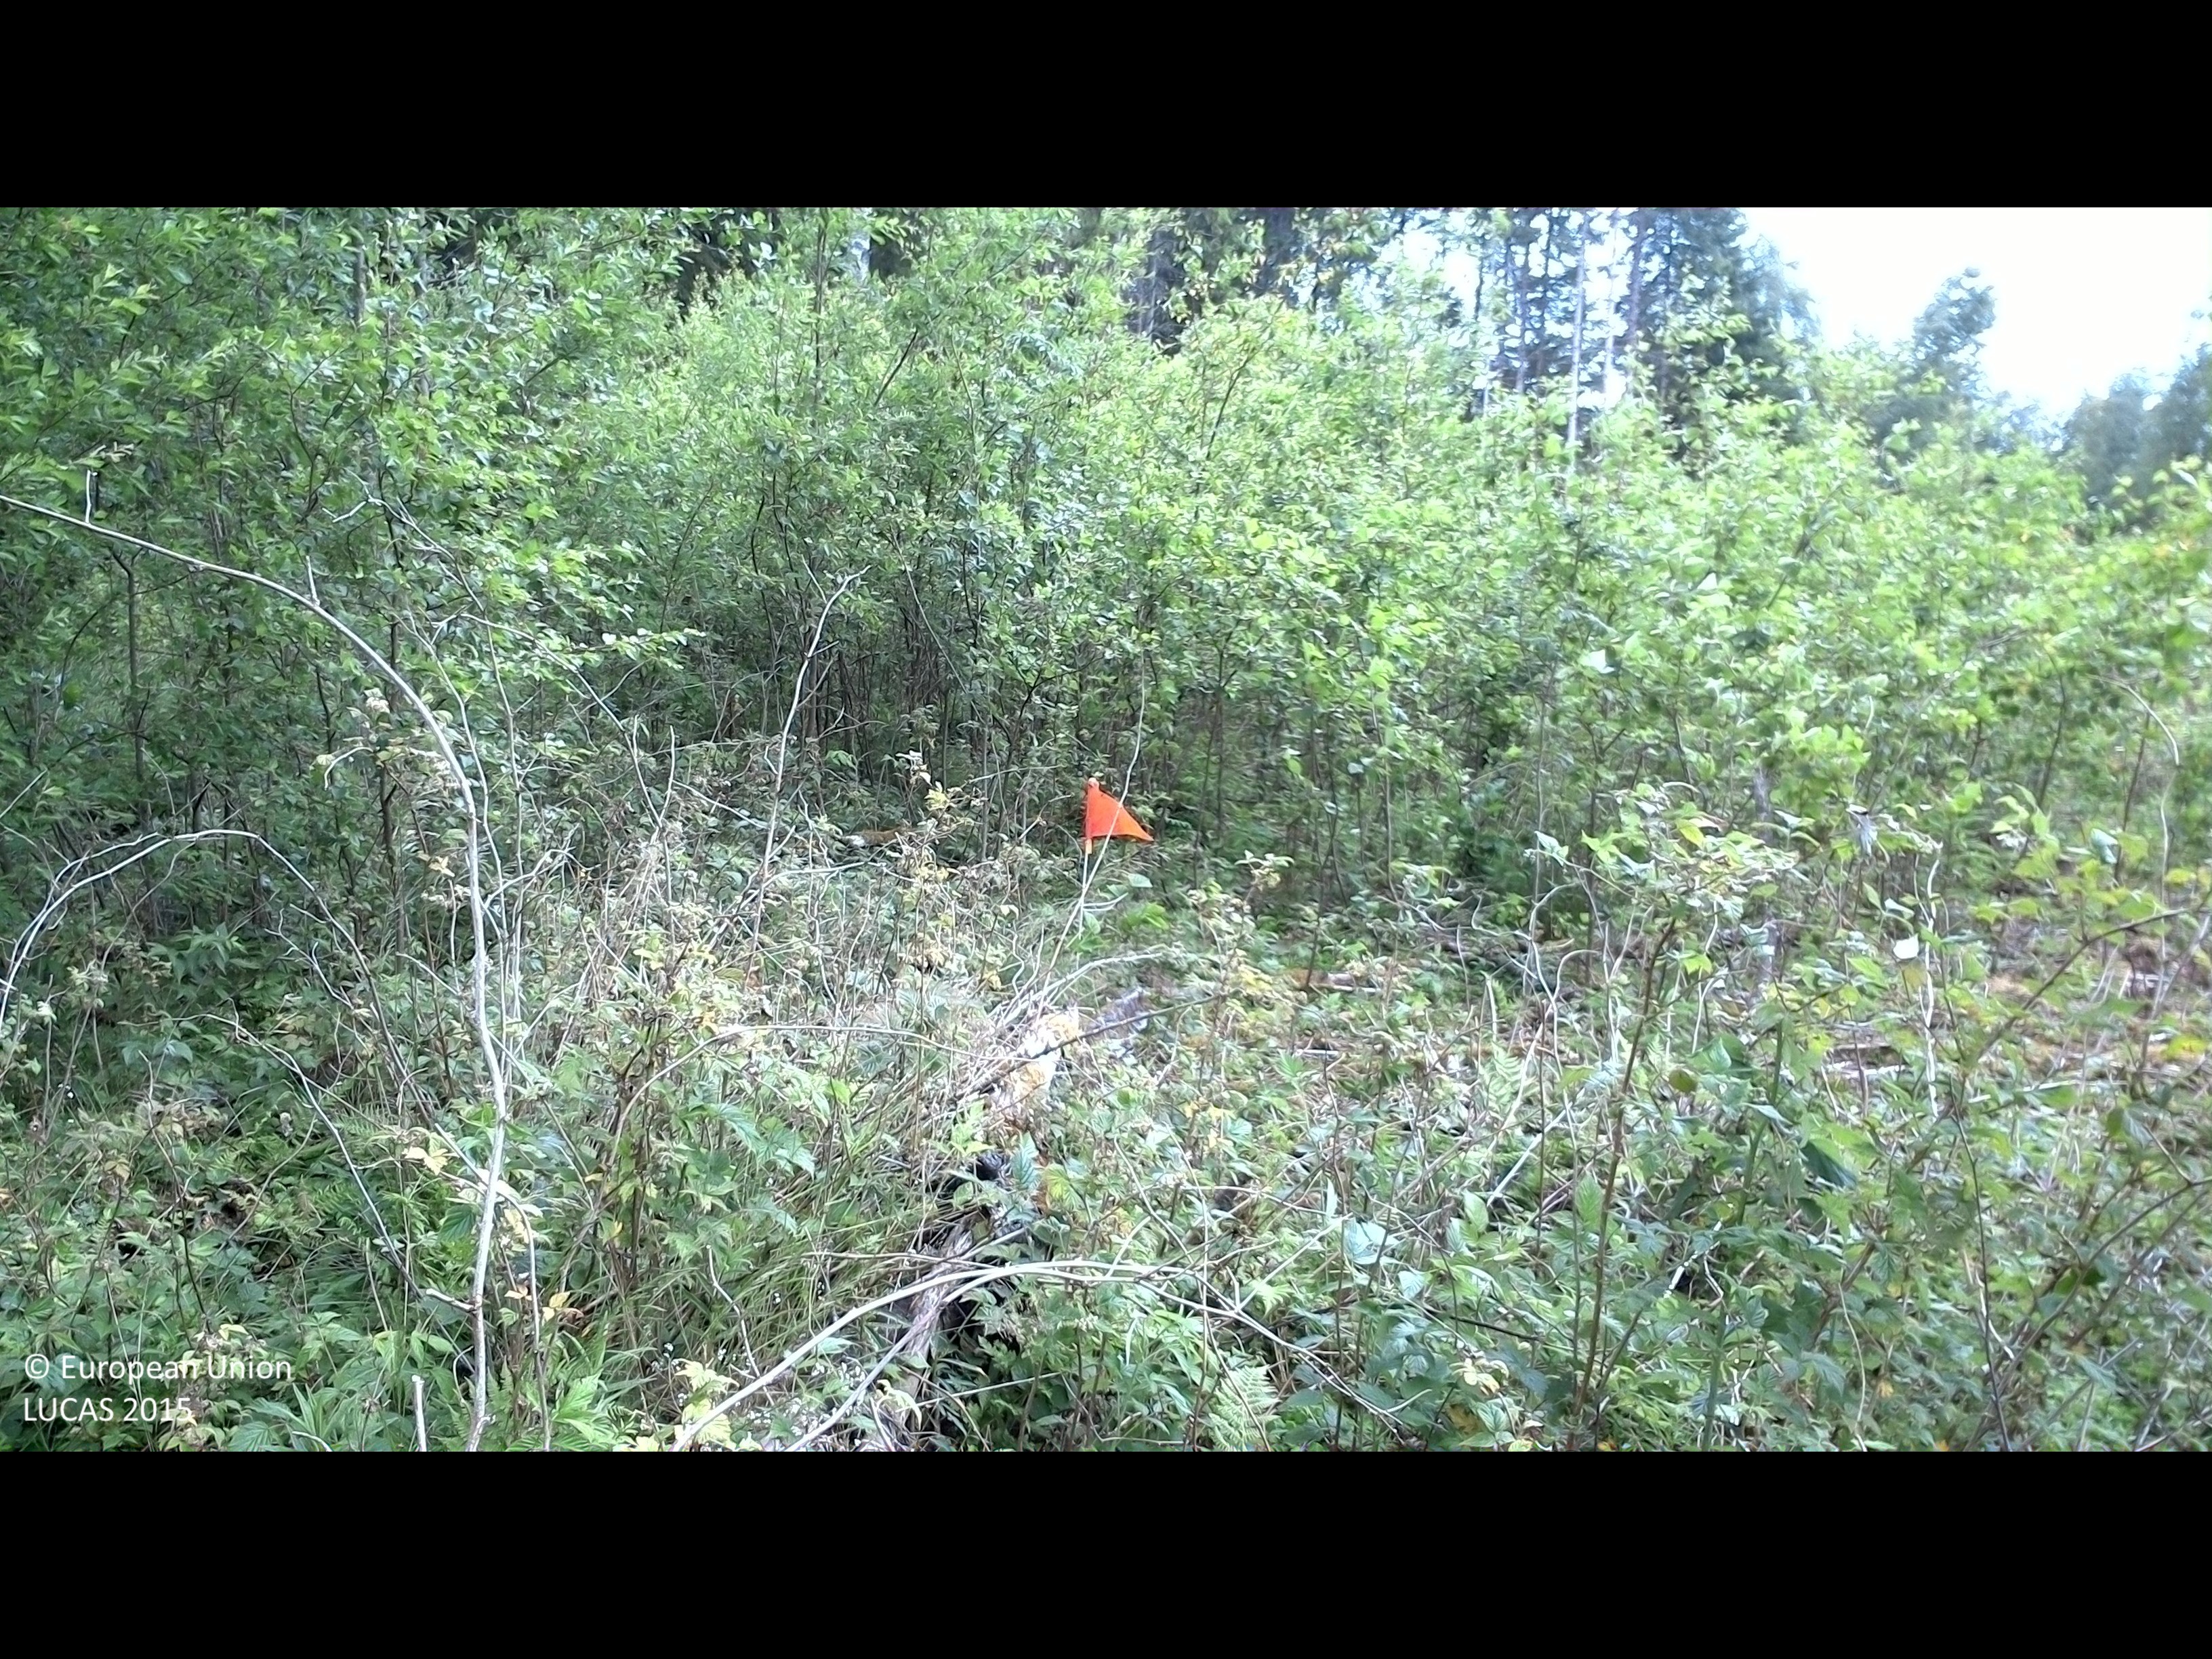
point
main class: Woodland
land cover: Broadleaved woodland
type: boreal forest
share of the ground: 50 - 75 %
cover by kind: broadleaved forest trees 65 %, shrubs 20 %, herbaceous plants 10 %, lichens and mosses 5 %
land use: Forestry
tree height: < 5 m
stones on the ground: < 10 %
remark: Clear cut
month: July
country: SE
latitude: 56.3735
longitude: 15.1312
